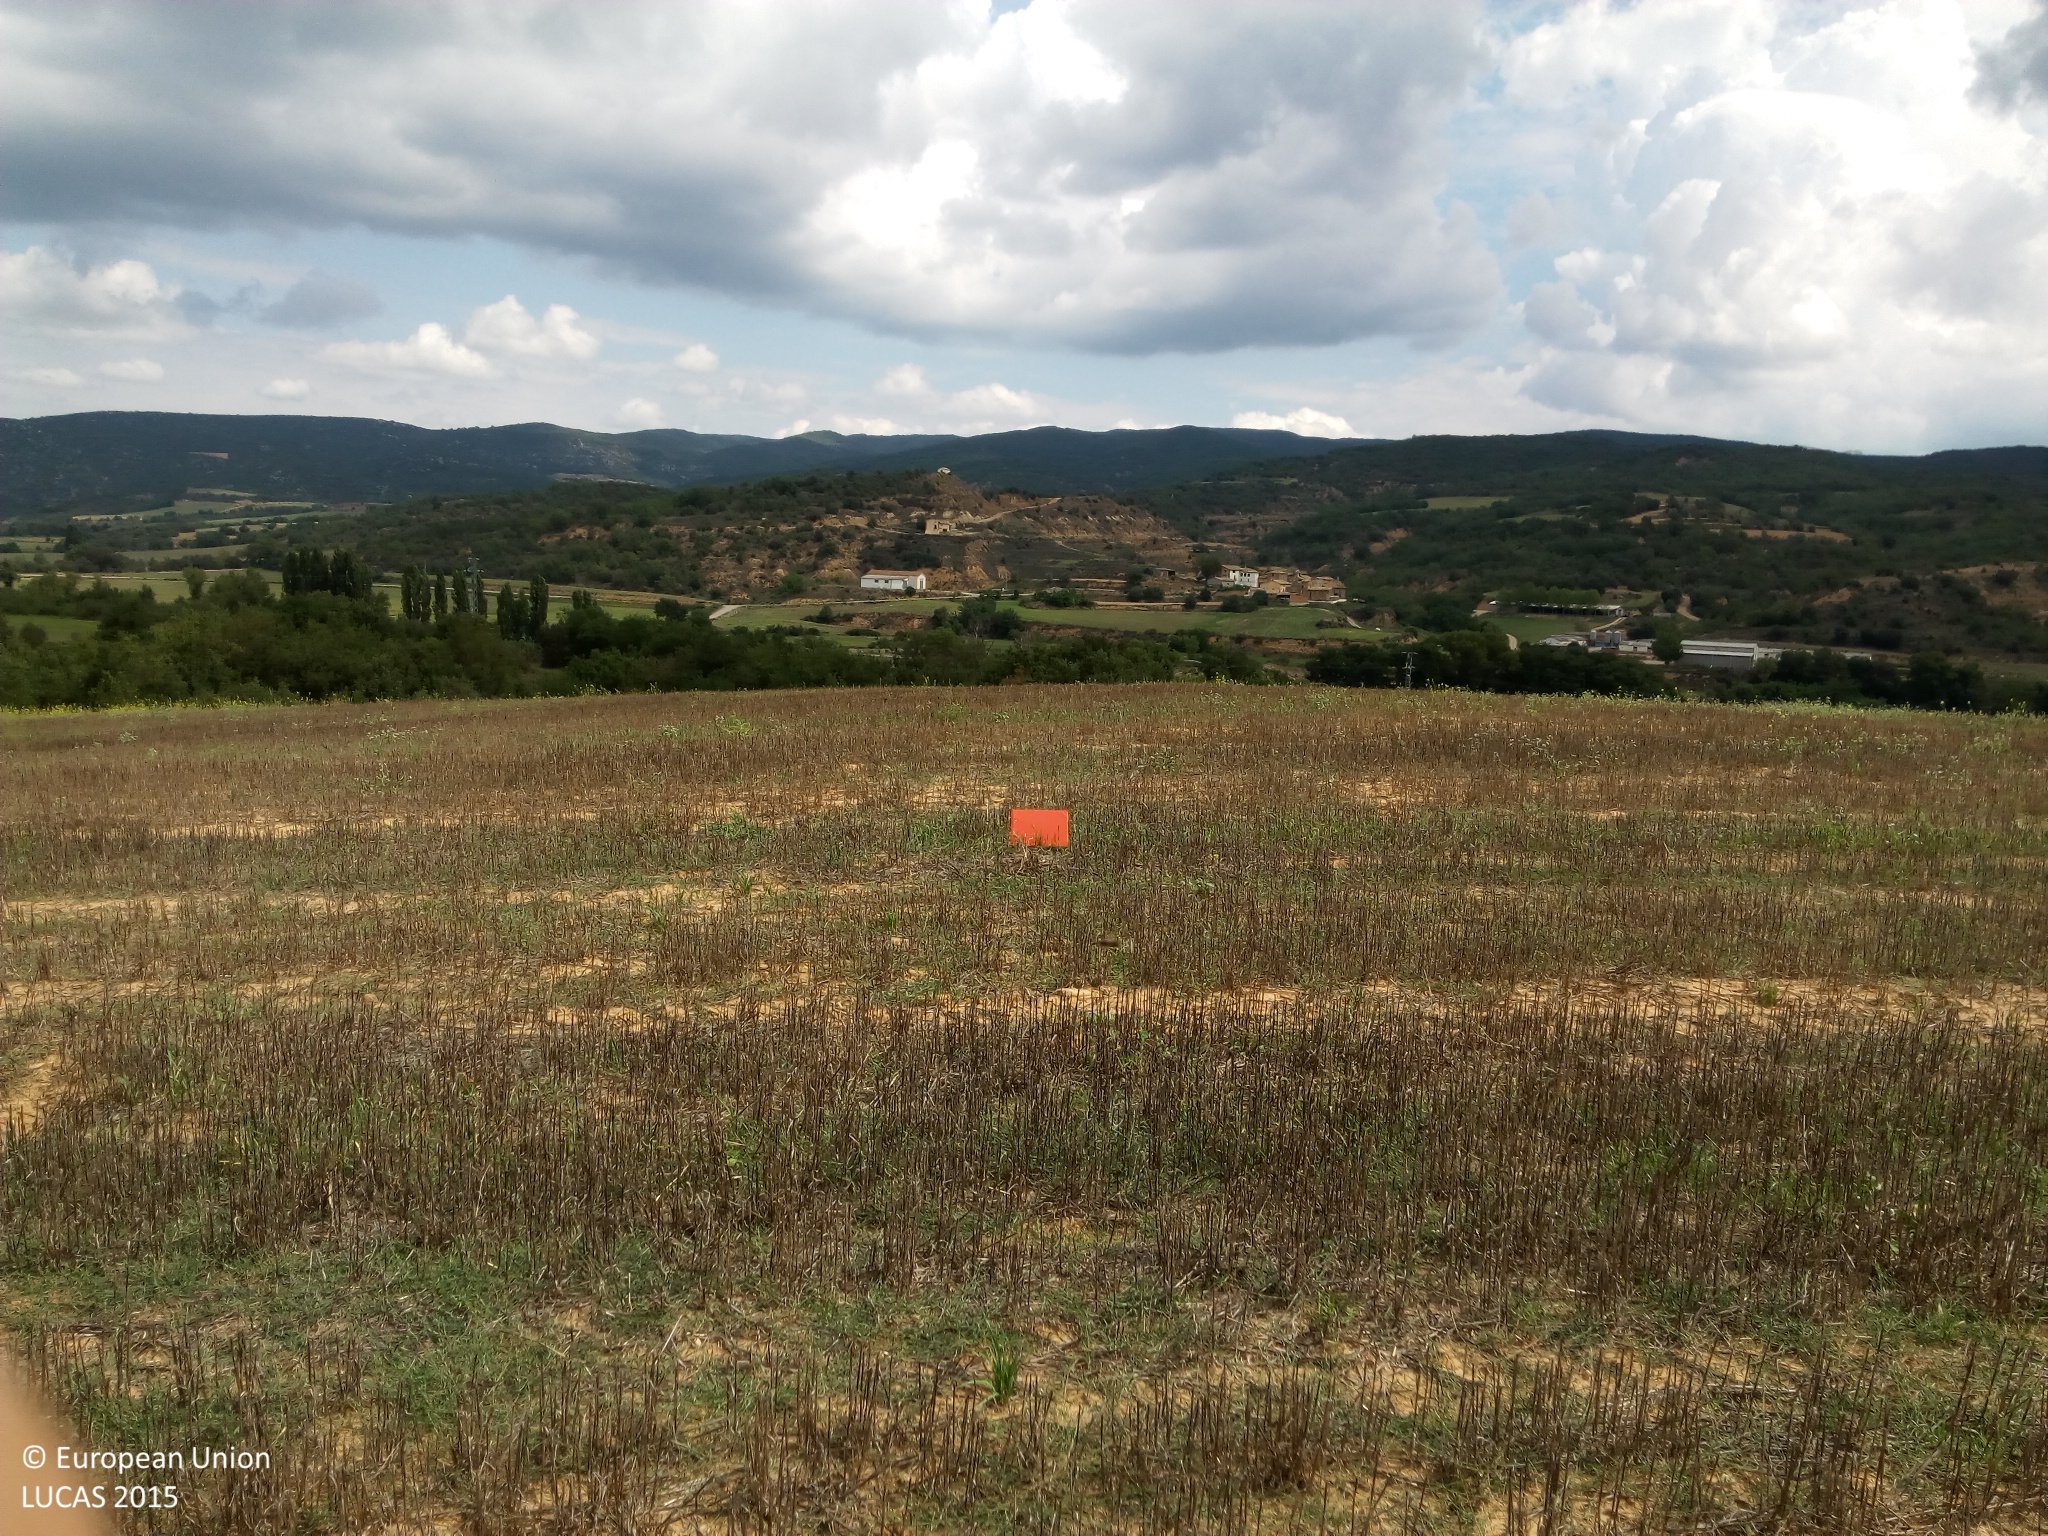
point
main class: Grassland
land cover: Spontaneously vegetated surfaces
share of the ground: > 75 %
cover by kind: unconsolidated bare surface 60 %, herbaceous plants 40 %
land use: Fallow land
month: August
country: ES
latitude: 42.0655
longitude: 0.5453
